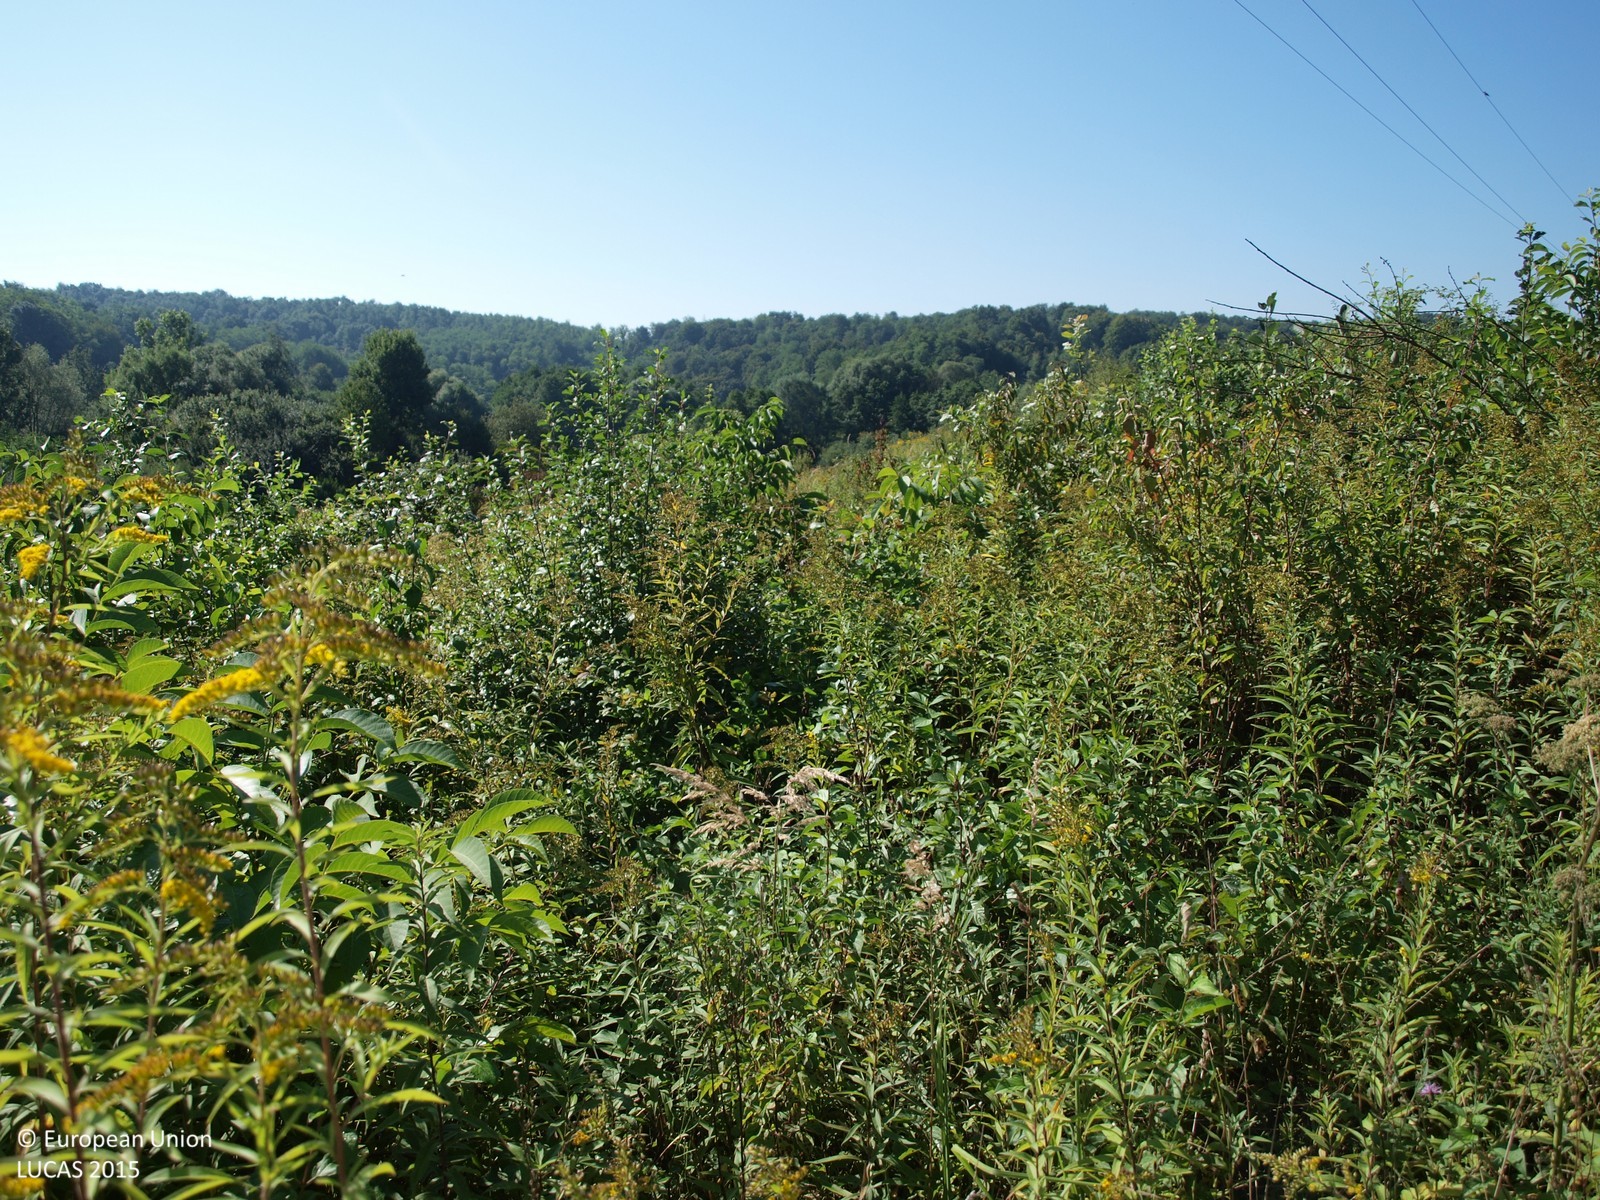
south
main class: Shrubland
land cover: Shrubland with sparse tree cover
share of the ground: > 75 %
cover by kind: shrubs 95 %, broadleaved forest trees 5 %
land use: Semi-natural and natural areas not in use
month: August
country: HR
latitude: 46.0909
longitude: 16.6353
